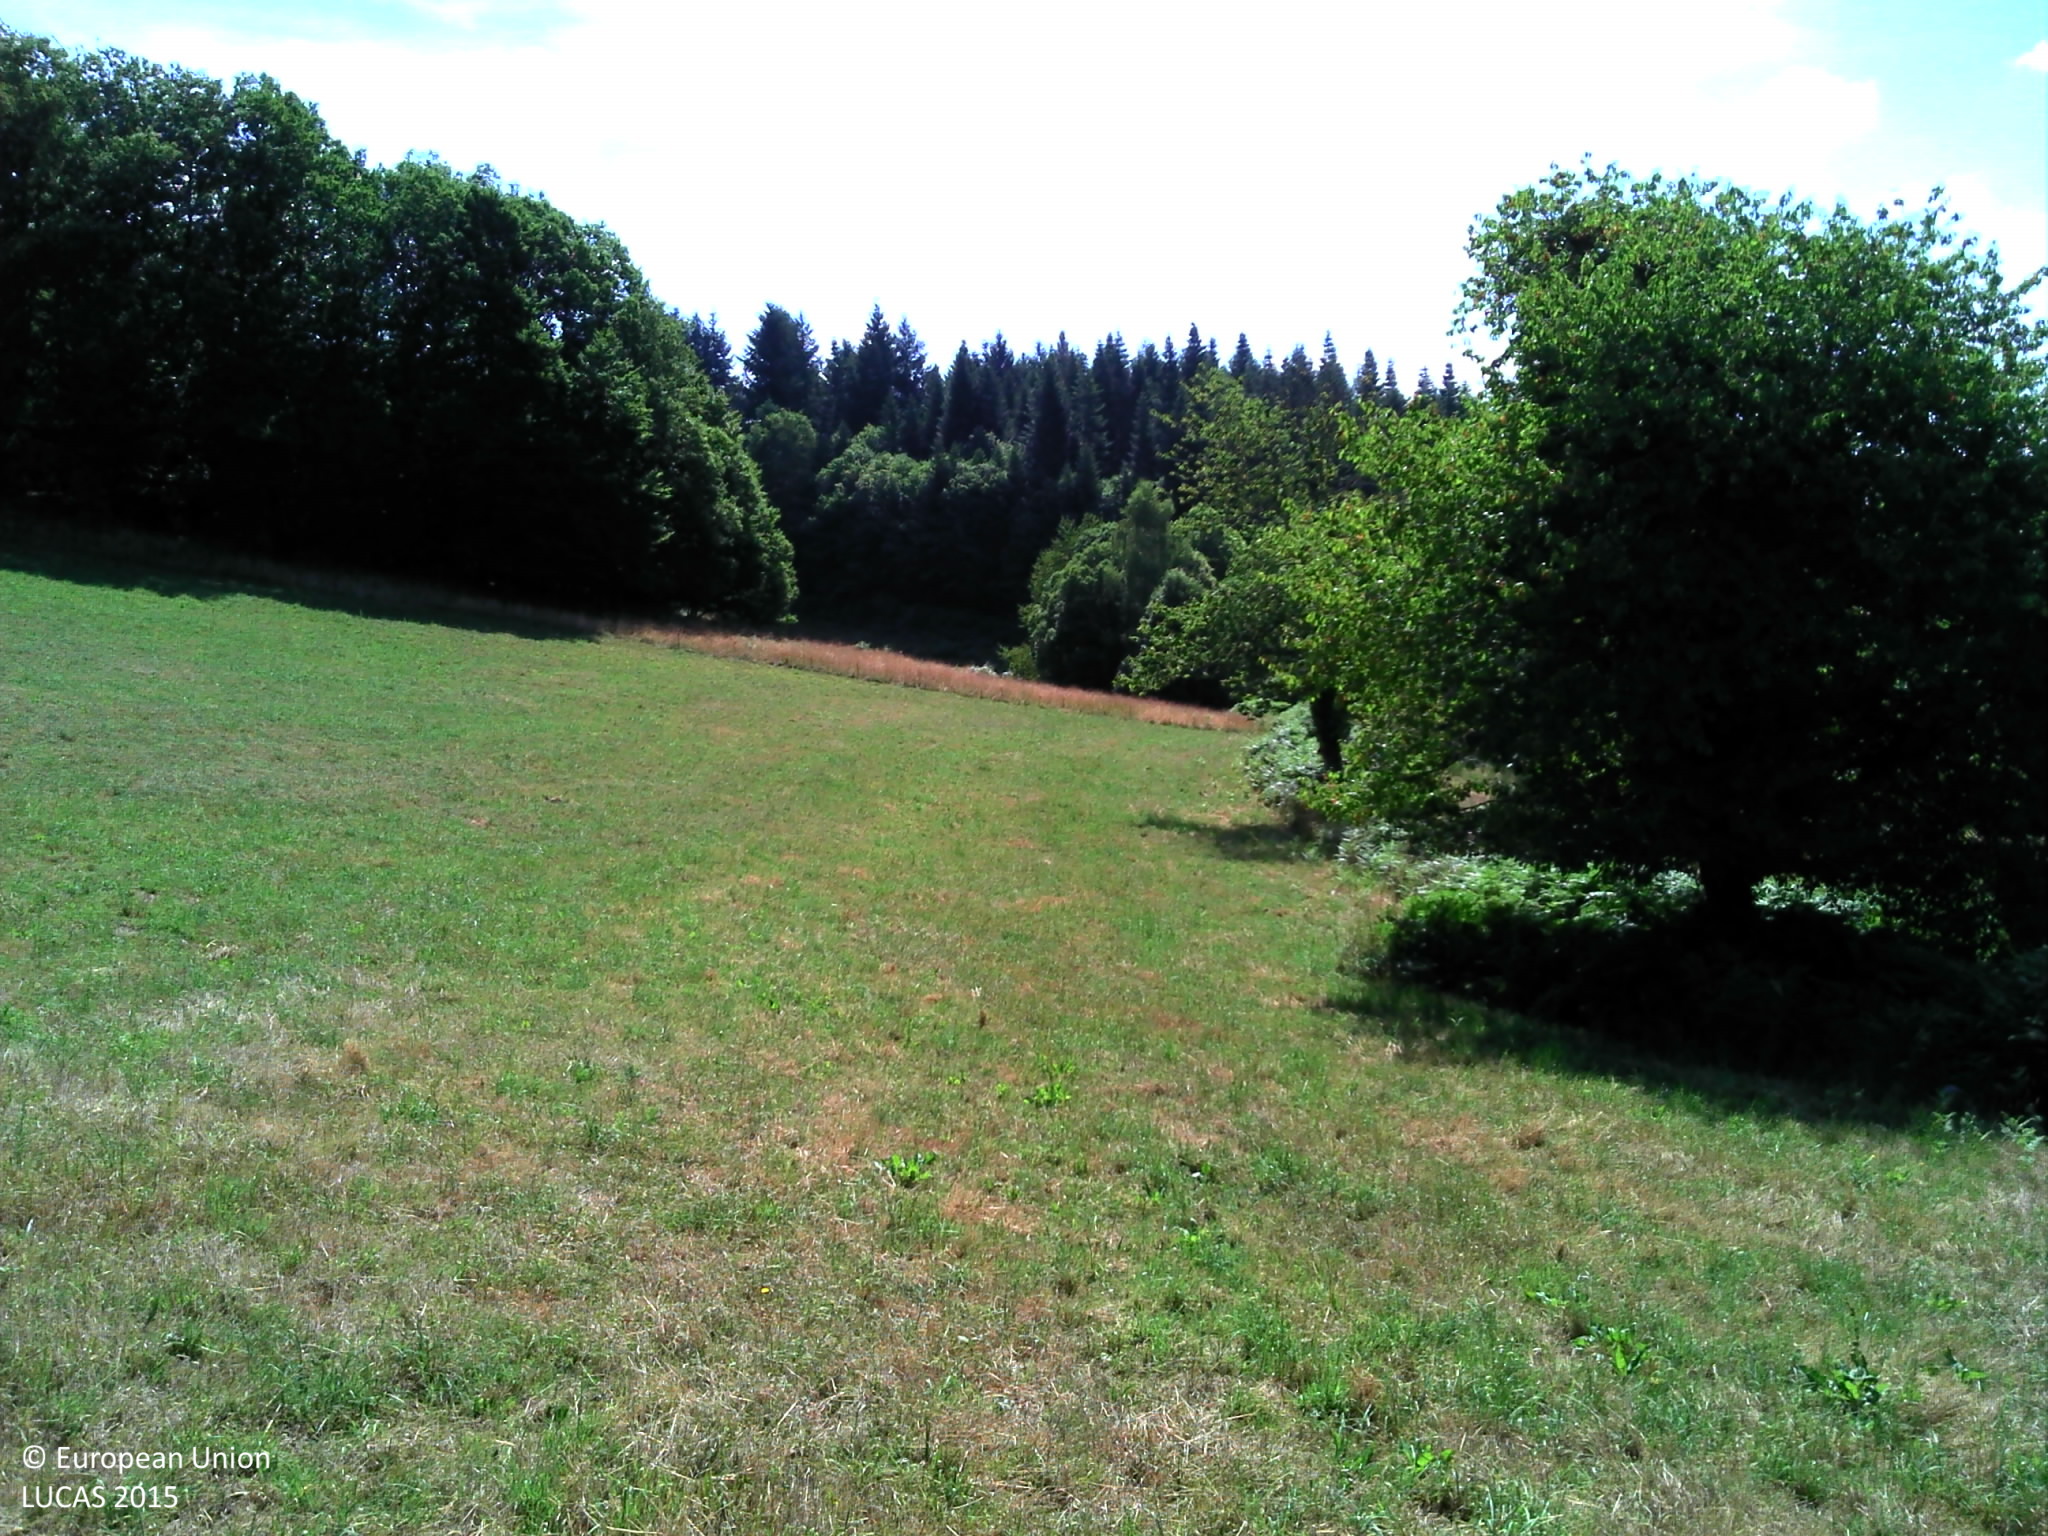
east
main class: Grassland
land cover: Grassland without tree/shrub cover
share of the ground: > 75 %
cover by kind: herbaceous plants 95 %
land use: Agriculture (excluding fallow land and kitchen gardens)
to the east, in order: Grassland without tree/shrub cover; Fences; Spruce dominated mixed woodland; Fences; Spontaneously vegetated surfaces
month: July
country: FR
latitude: 45.7767
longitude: 1.7243
